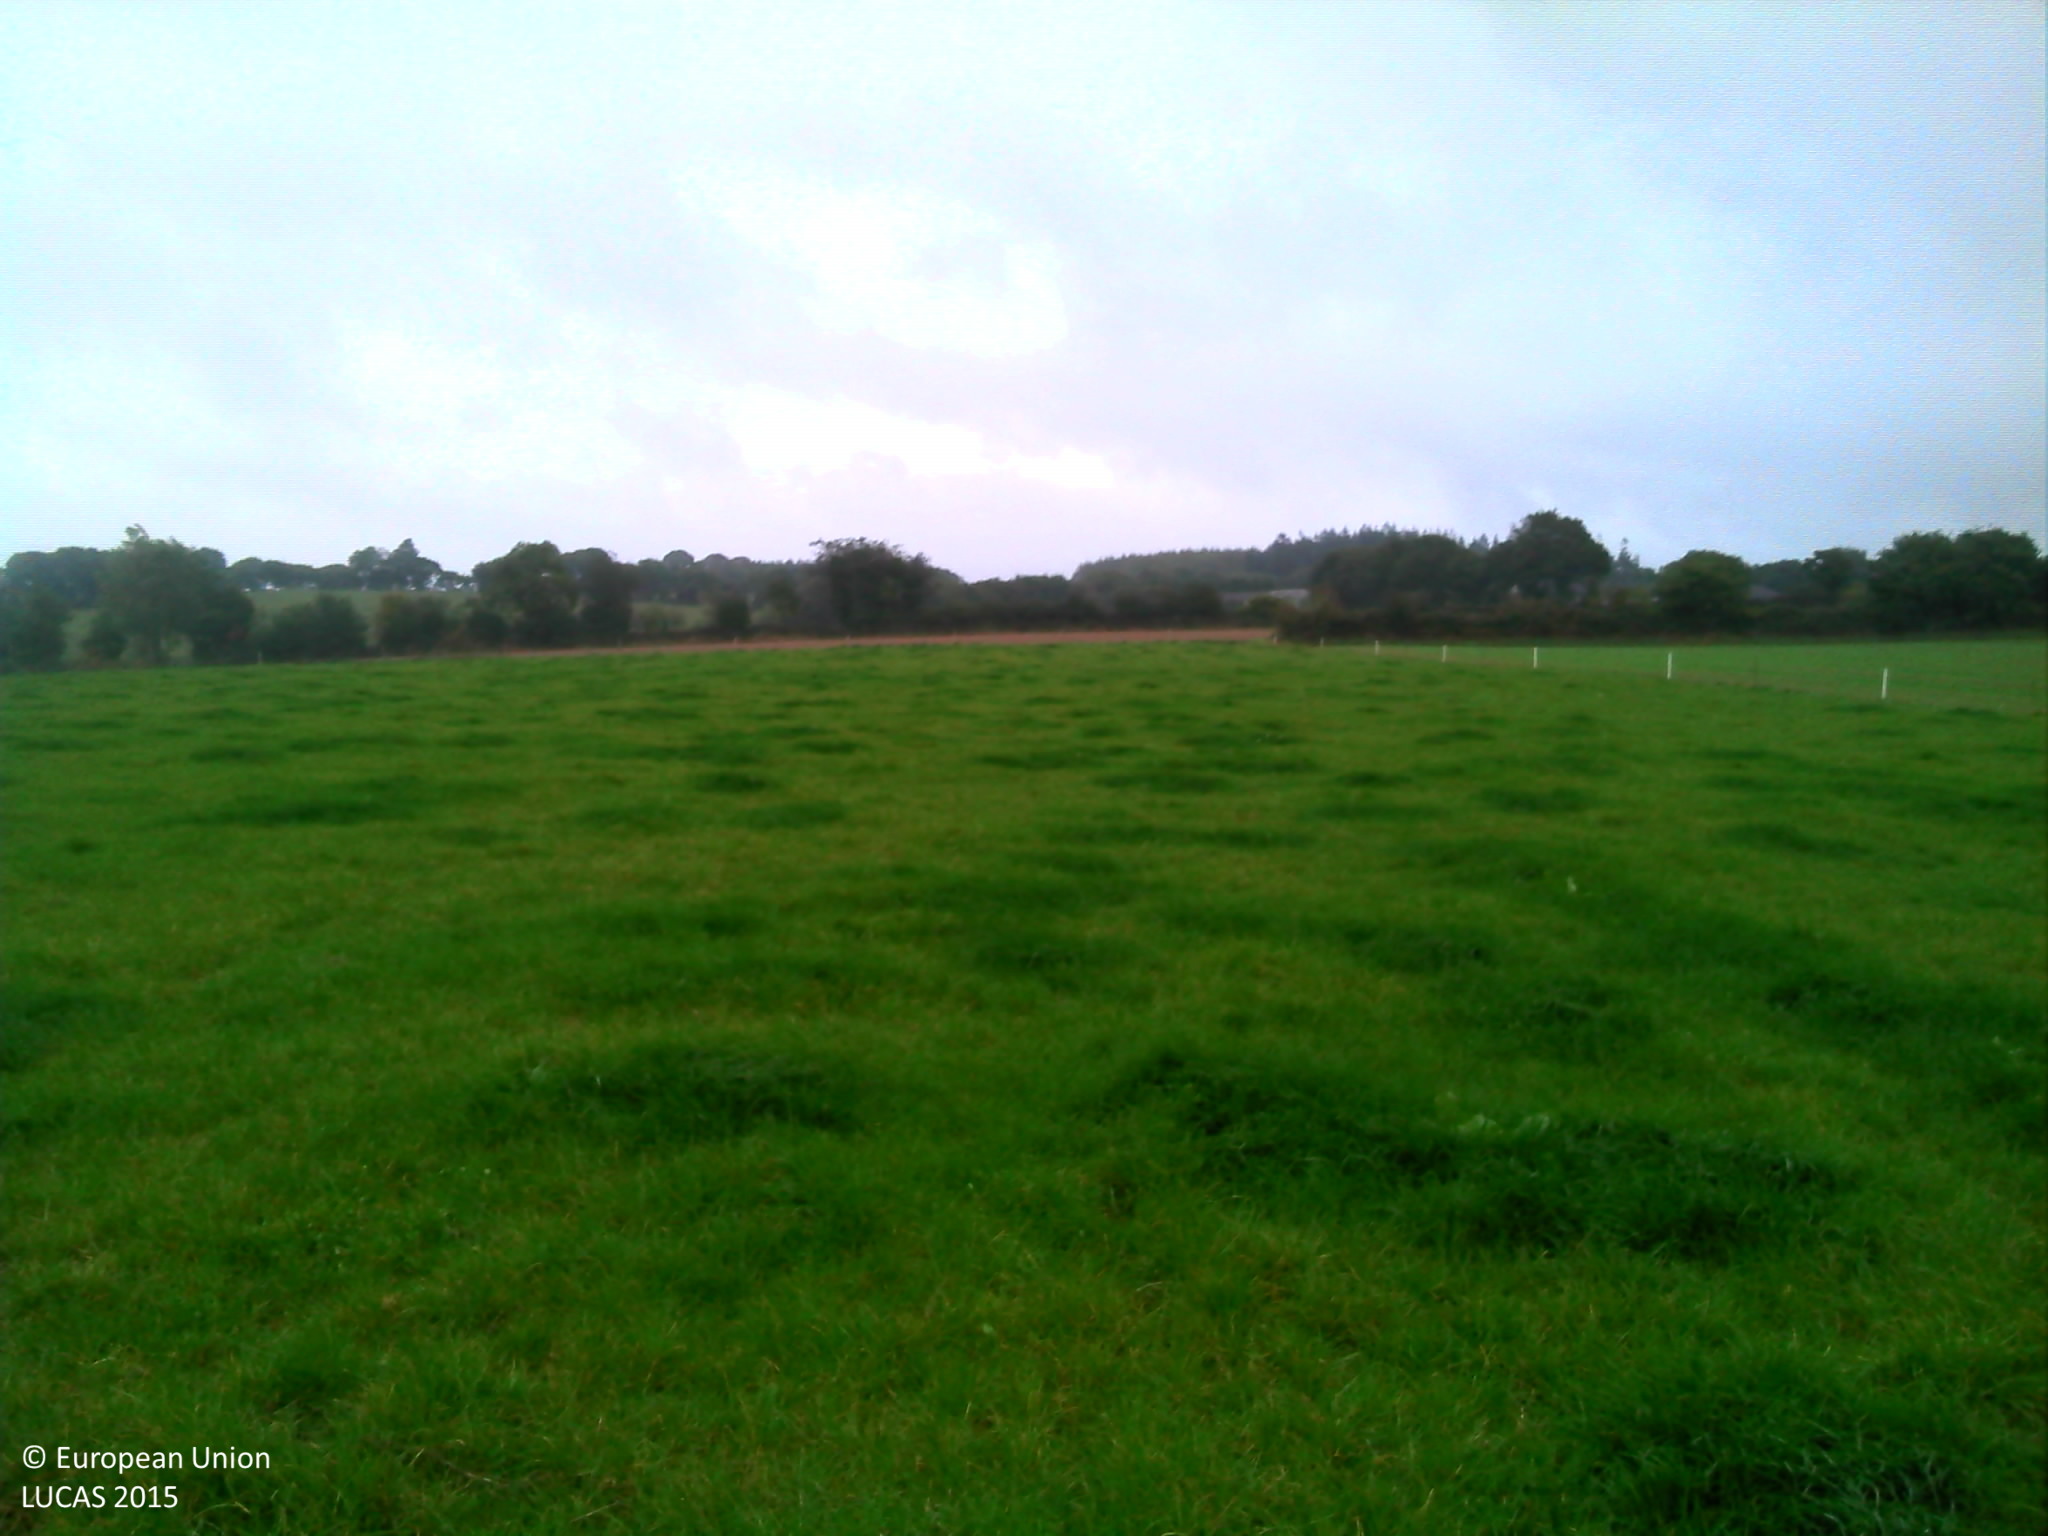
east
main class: Grassland
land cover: Grassland without tree/shrub cover
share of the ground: > 75 %
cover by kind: herbaceous plants 100 %
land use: Agriculture (excluding fallow land and kitchen gardens)
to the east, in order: Grassland without tree/shrub cover; Fences; Other bare soil; Fences; Abandoned hedges; Grassland without tree/shrub cover
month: August
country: FR
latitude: 48.3290
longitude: -3.4167
